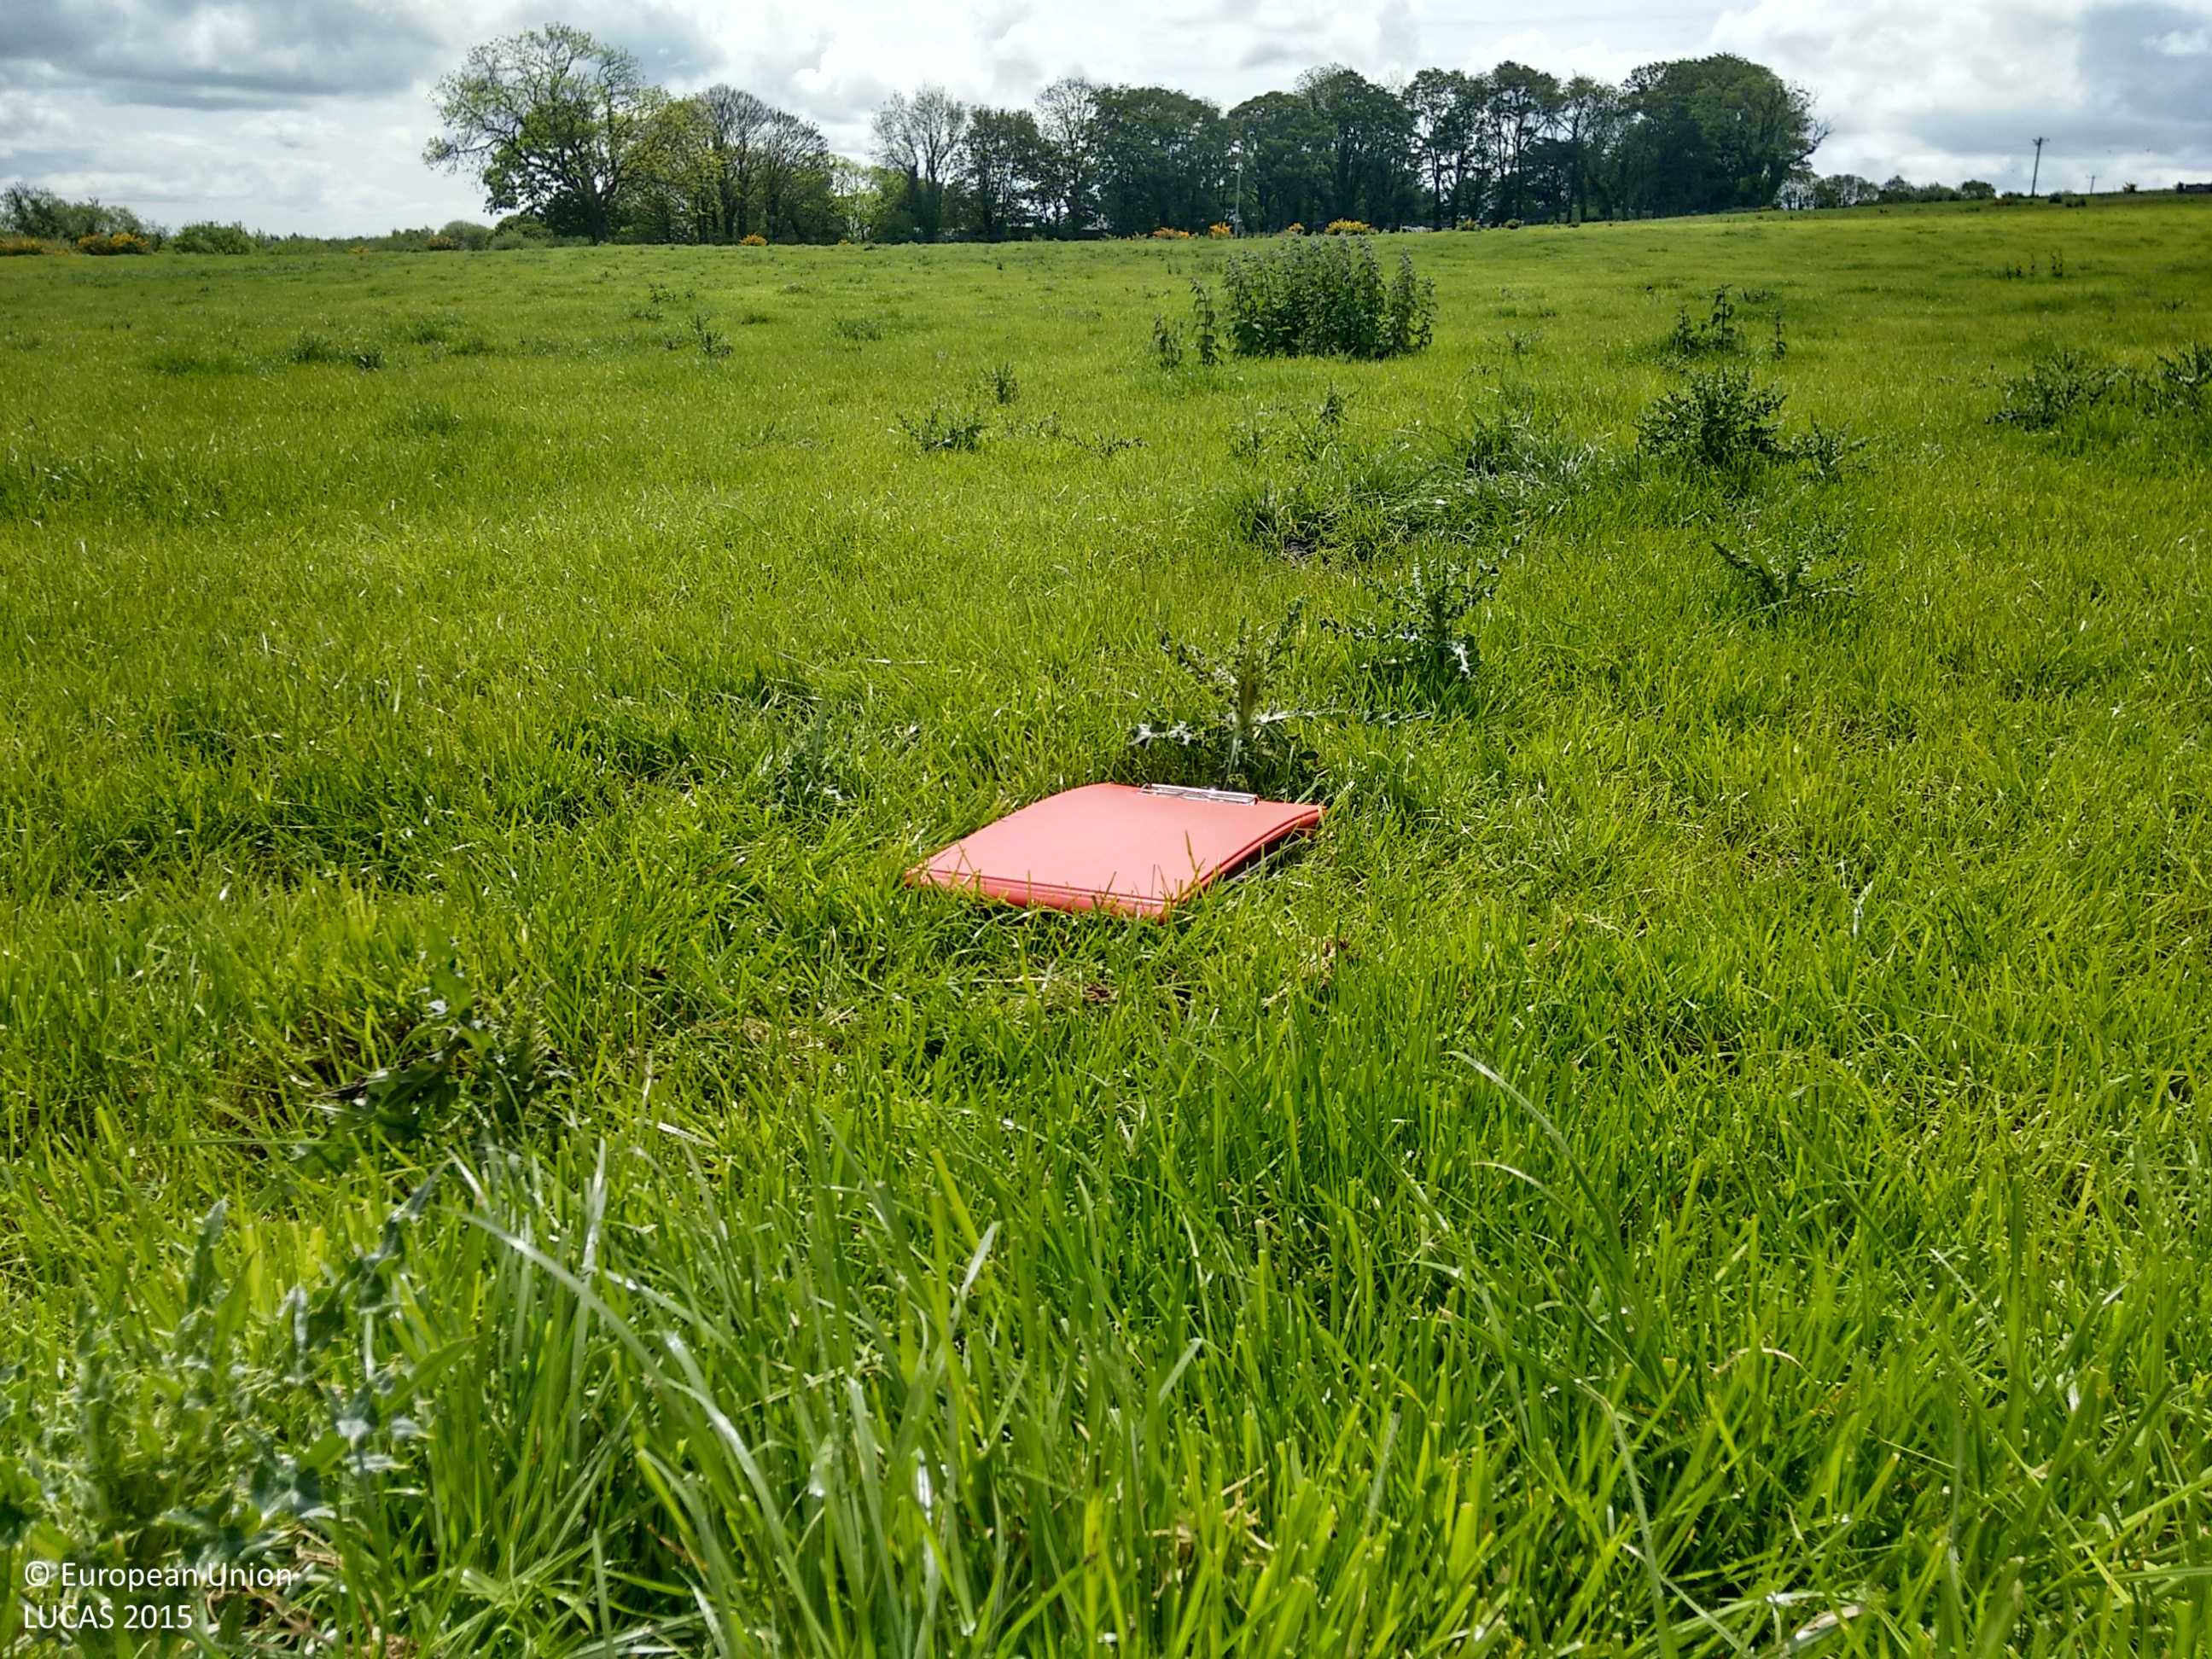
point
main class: Grassland
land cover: Grassland without tree/shrub cover
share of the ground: > 75 %
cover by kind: herbaceous plants 100 %
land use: Agriculture (excluding fallow land and kitchen gardens)
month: May
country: IE
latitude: 51.8229
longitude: -8.7601
